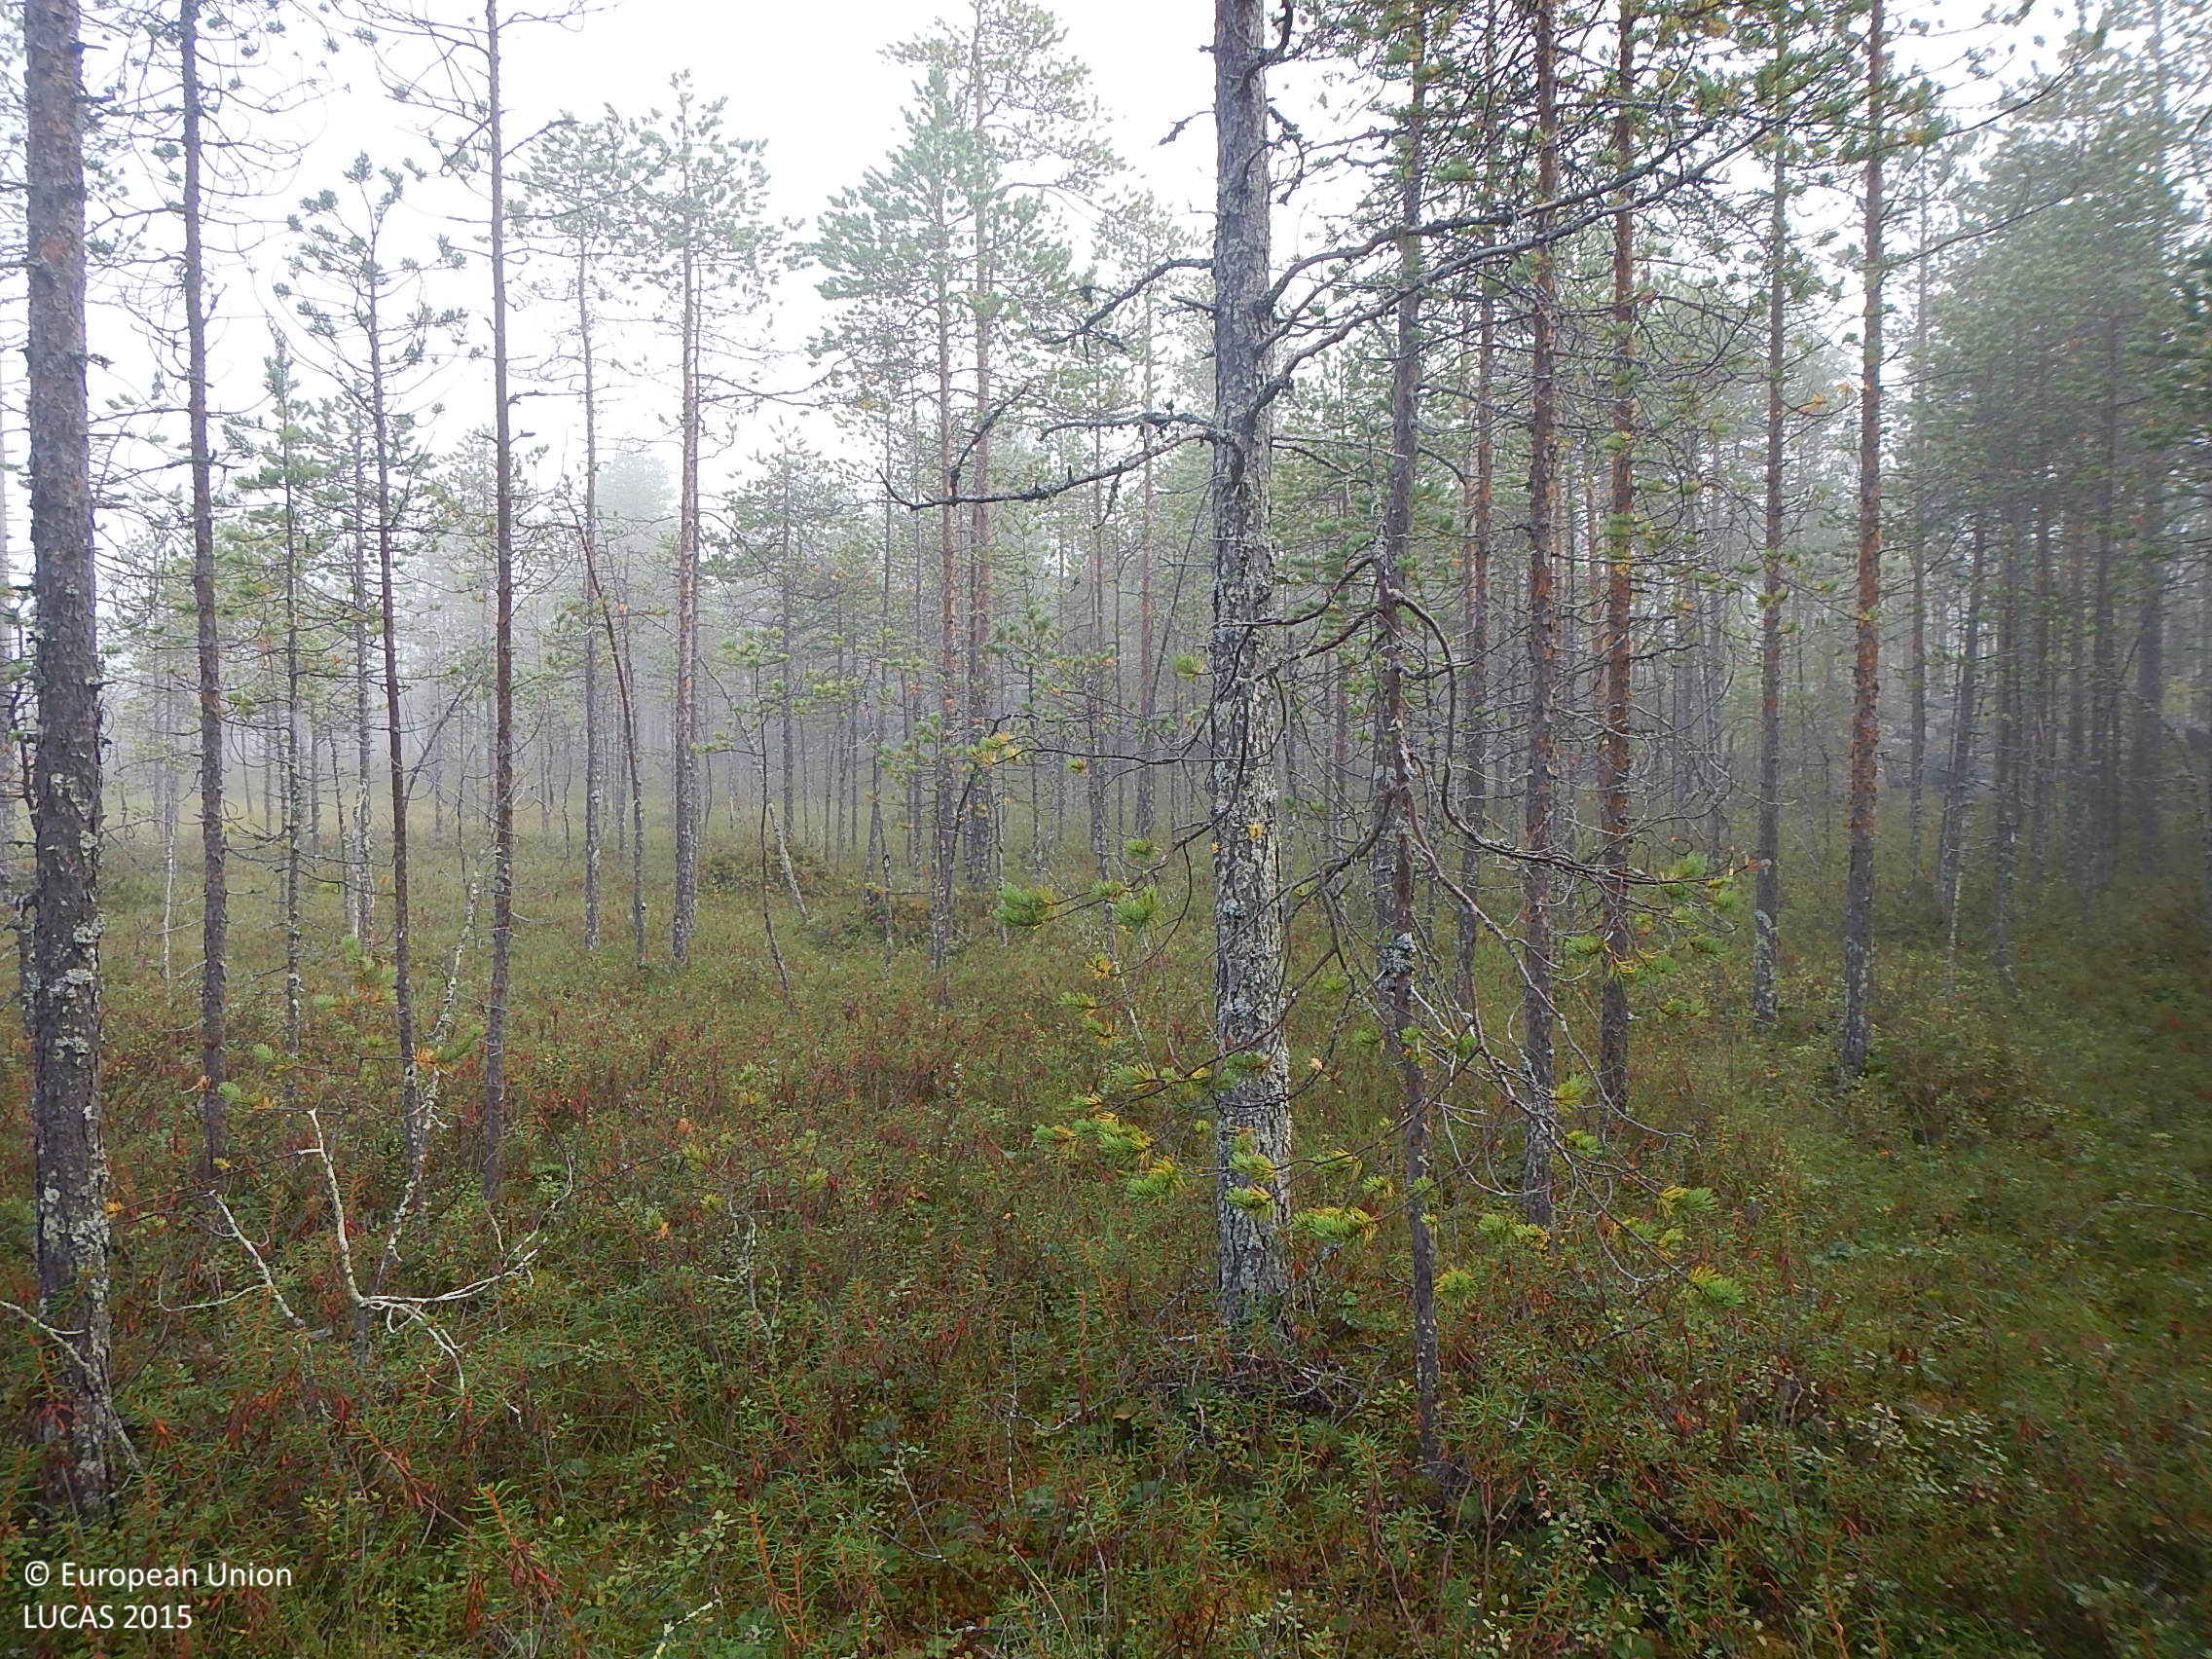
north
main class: Woodland
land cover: Pine dominated coniferous woodland
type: mire and swamp forests
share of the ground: 25 - 50 %
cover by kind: coniferous forest trees 45 %, shrubs 40 %, herbaceous plants 10 %, lichens and mosses 5 %
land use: Forestry
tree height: > 5 m
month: August
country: FI
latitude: 65.5148
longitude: 27.0026
